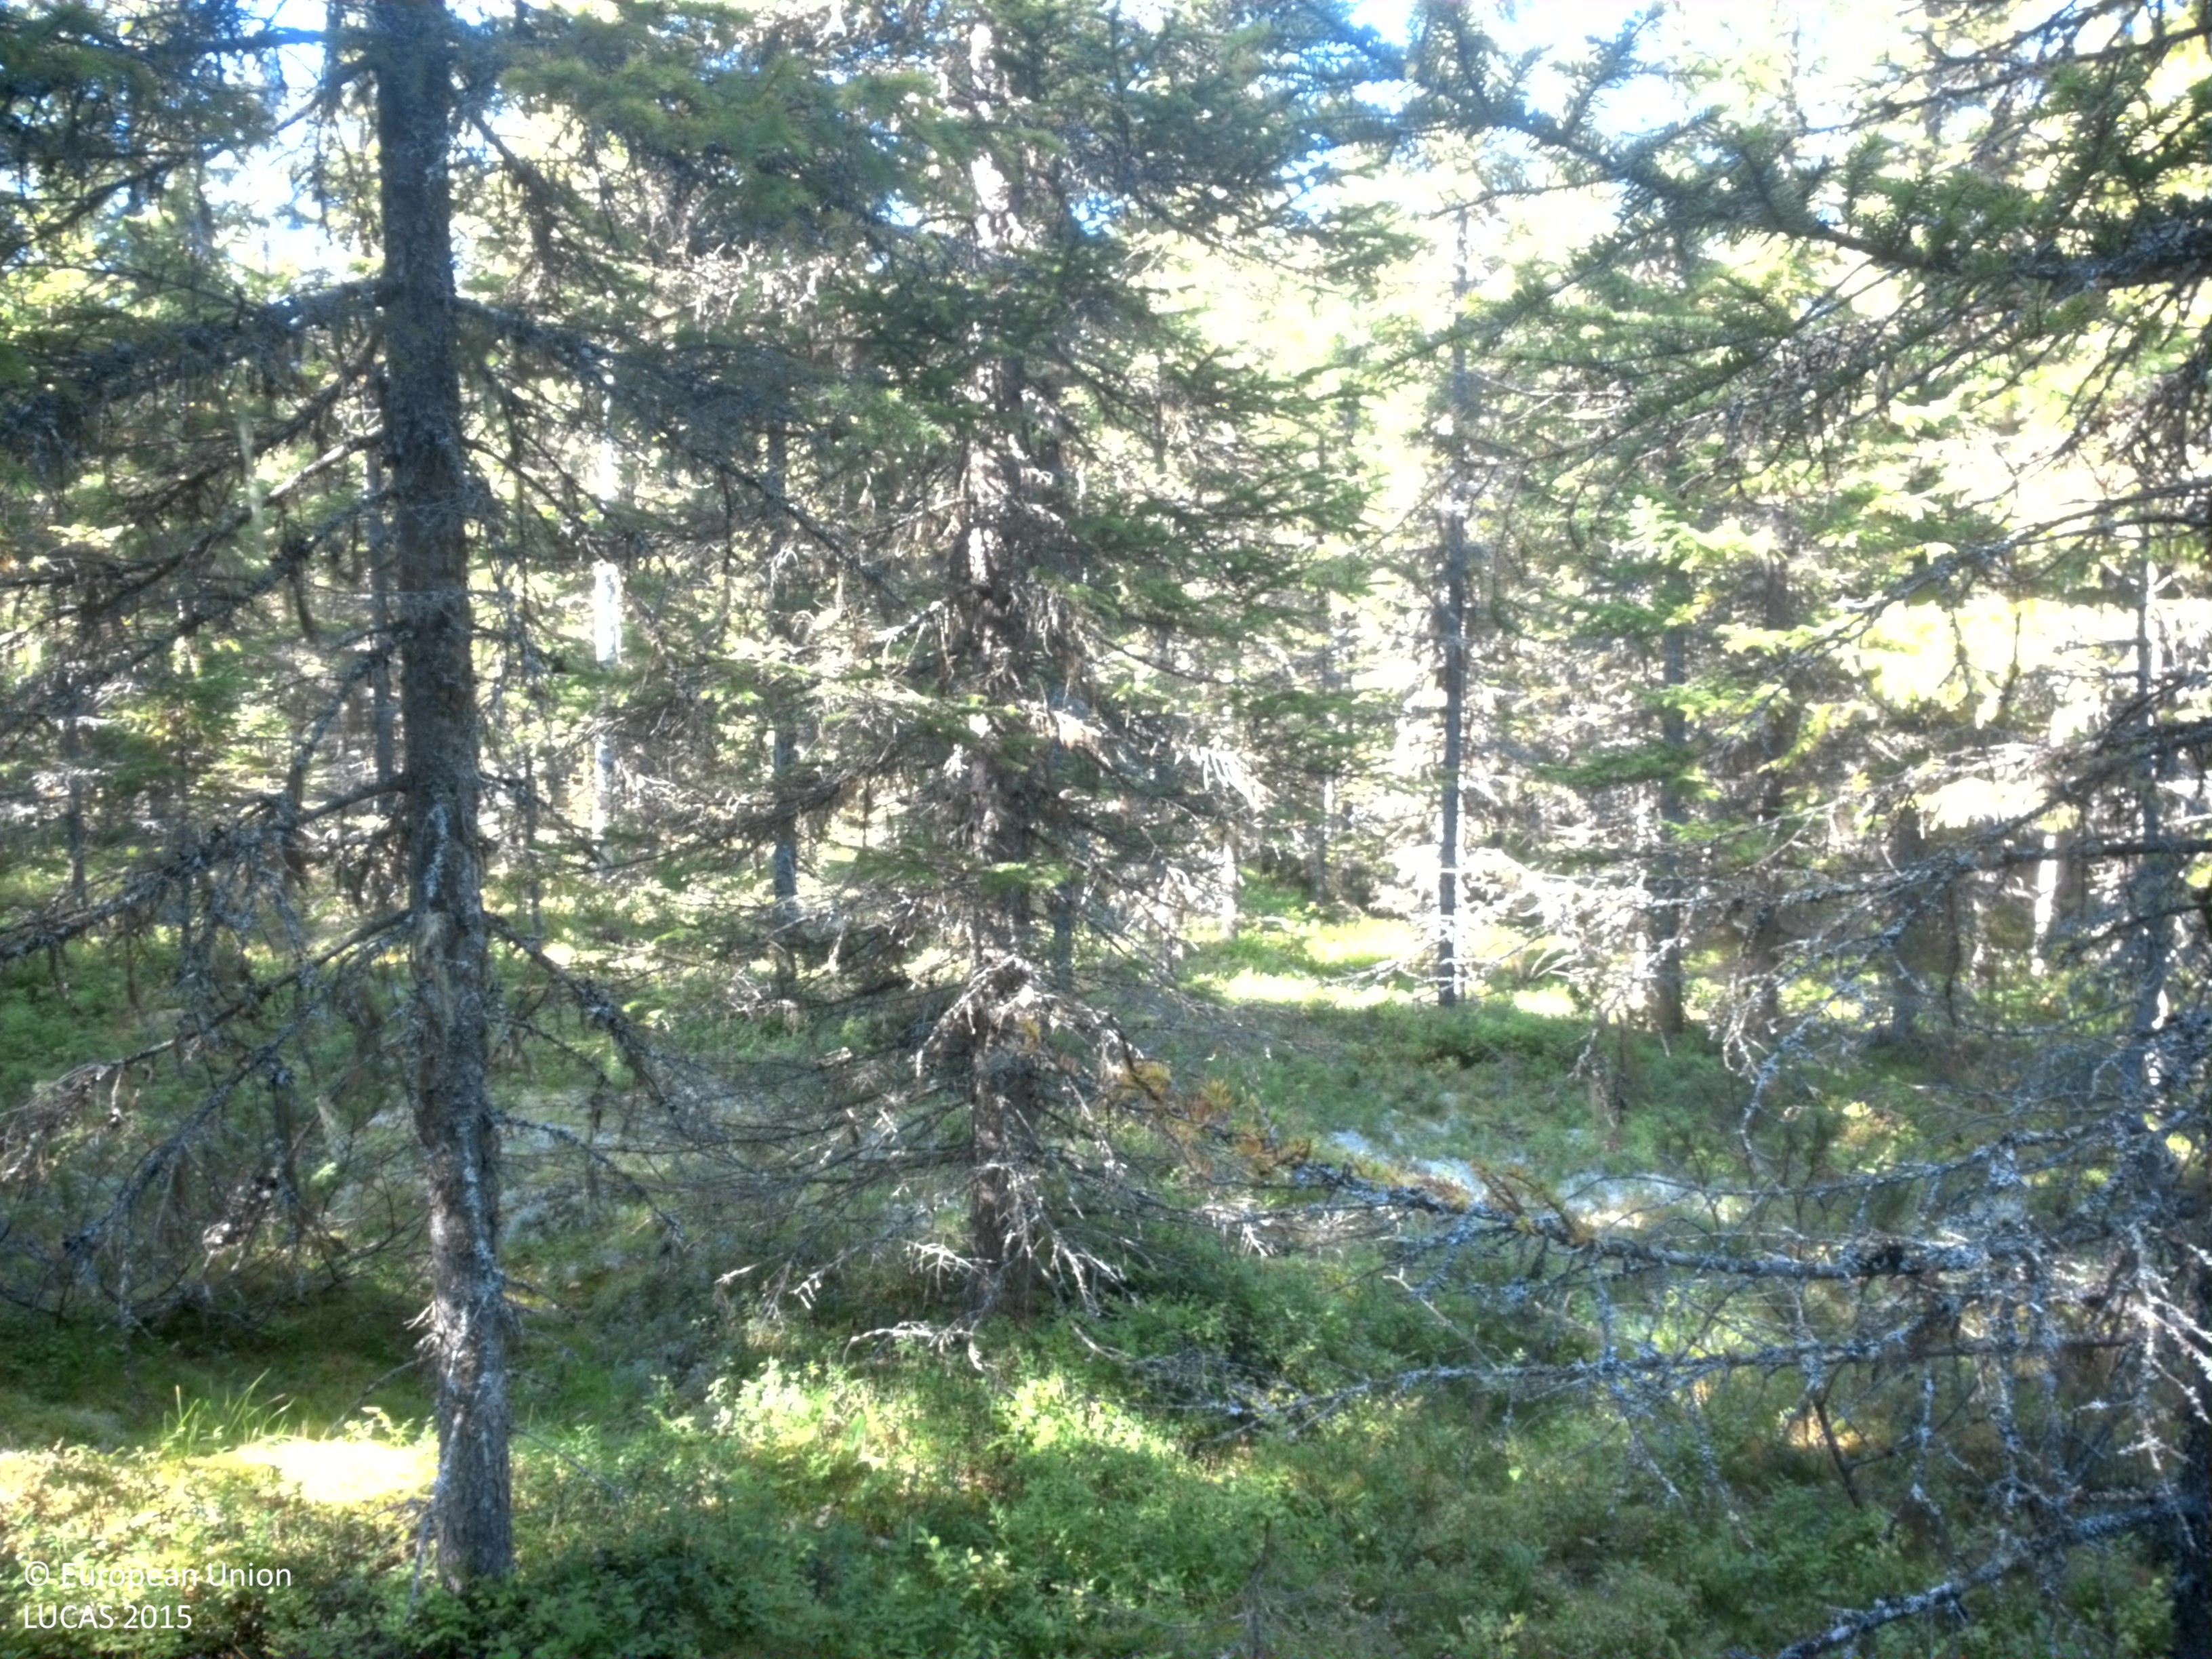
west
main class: Woodland
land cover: Spruce dominated coniferous woodland
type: boreal forest
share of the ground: 50 - 75 %
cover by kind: coniferous forest trees 65 %, shrubs 25 %, lichens and mosses 10 %
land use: Forestry
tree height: > 5 m
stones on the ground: 25 - 50 %
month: September
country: SE
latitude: 64.2624
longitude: 19.7373
